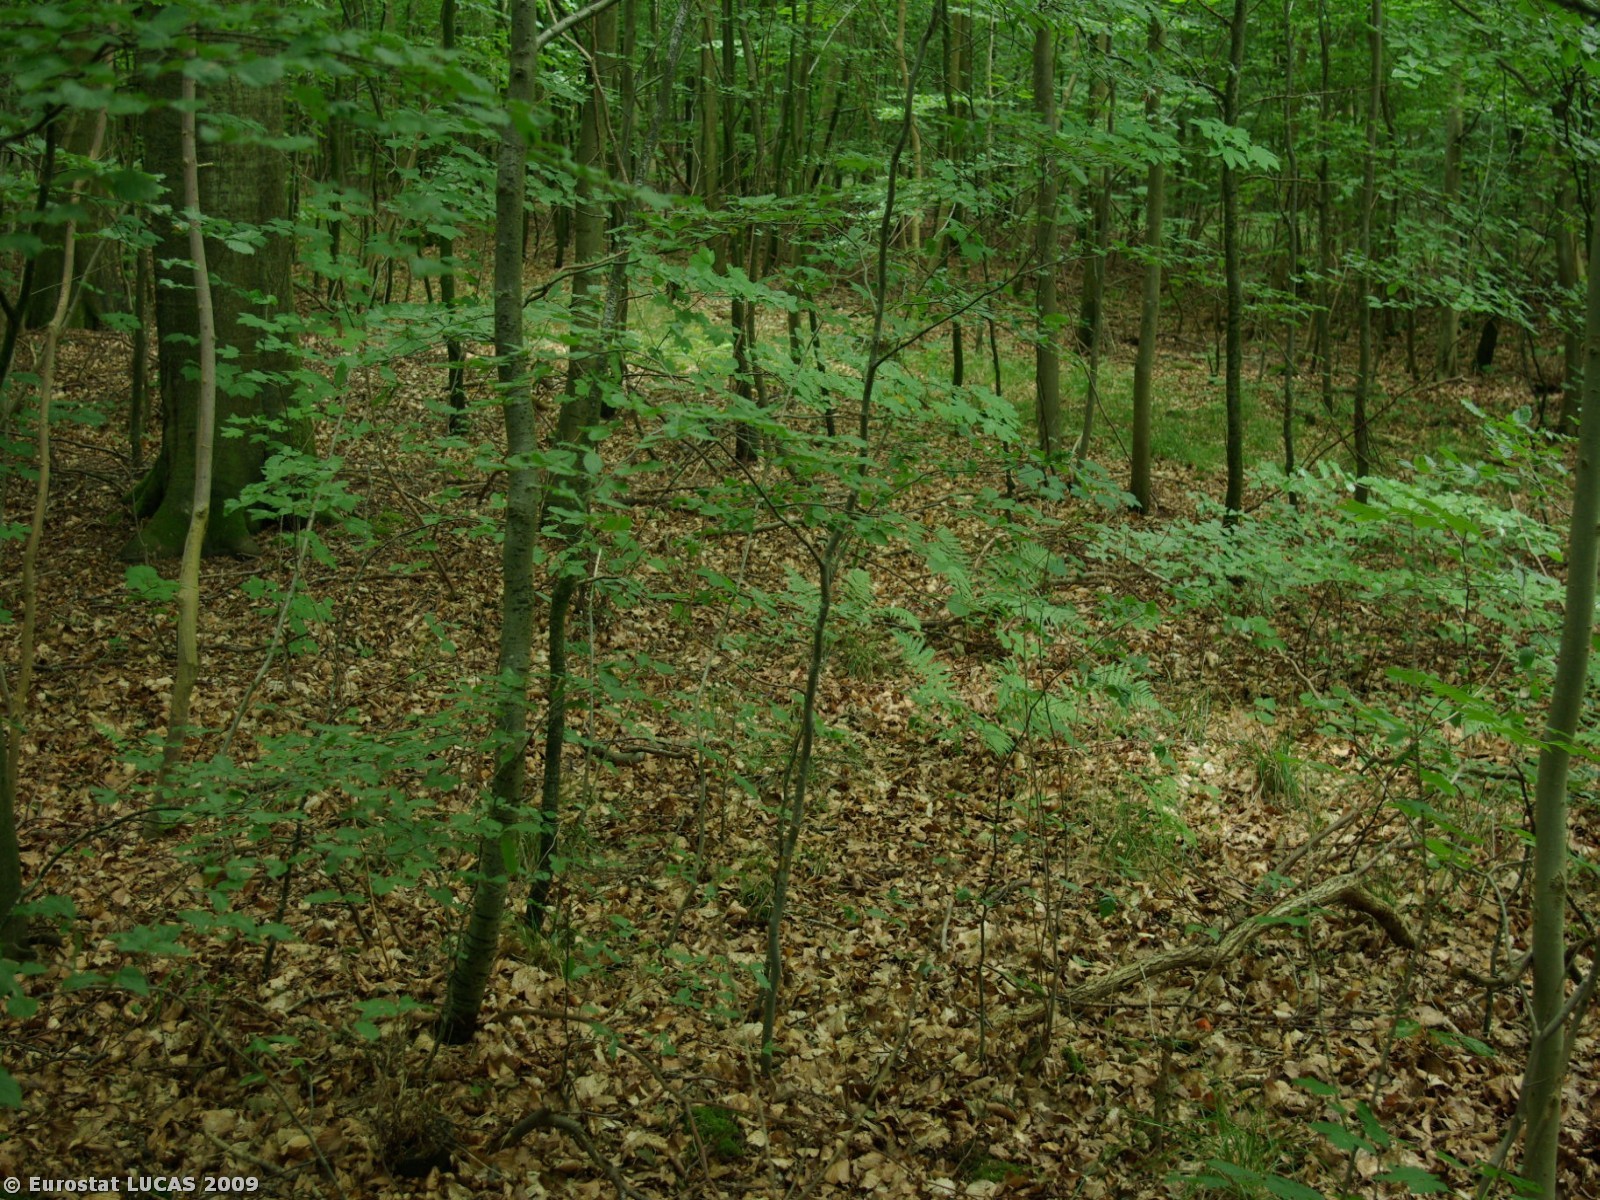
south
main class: Woodland
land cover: Broadleaved woodland
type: mesophytic deciduous forest
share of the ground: > 75 %
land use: Forestry
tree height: > 5 m
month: July
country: DK
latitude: 55.0194
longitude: 9.8906
